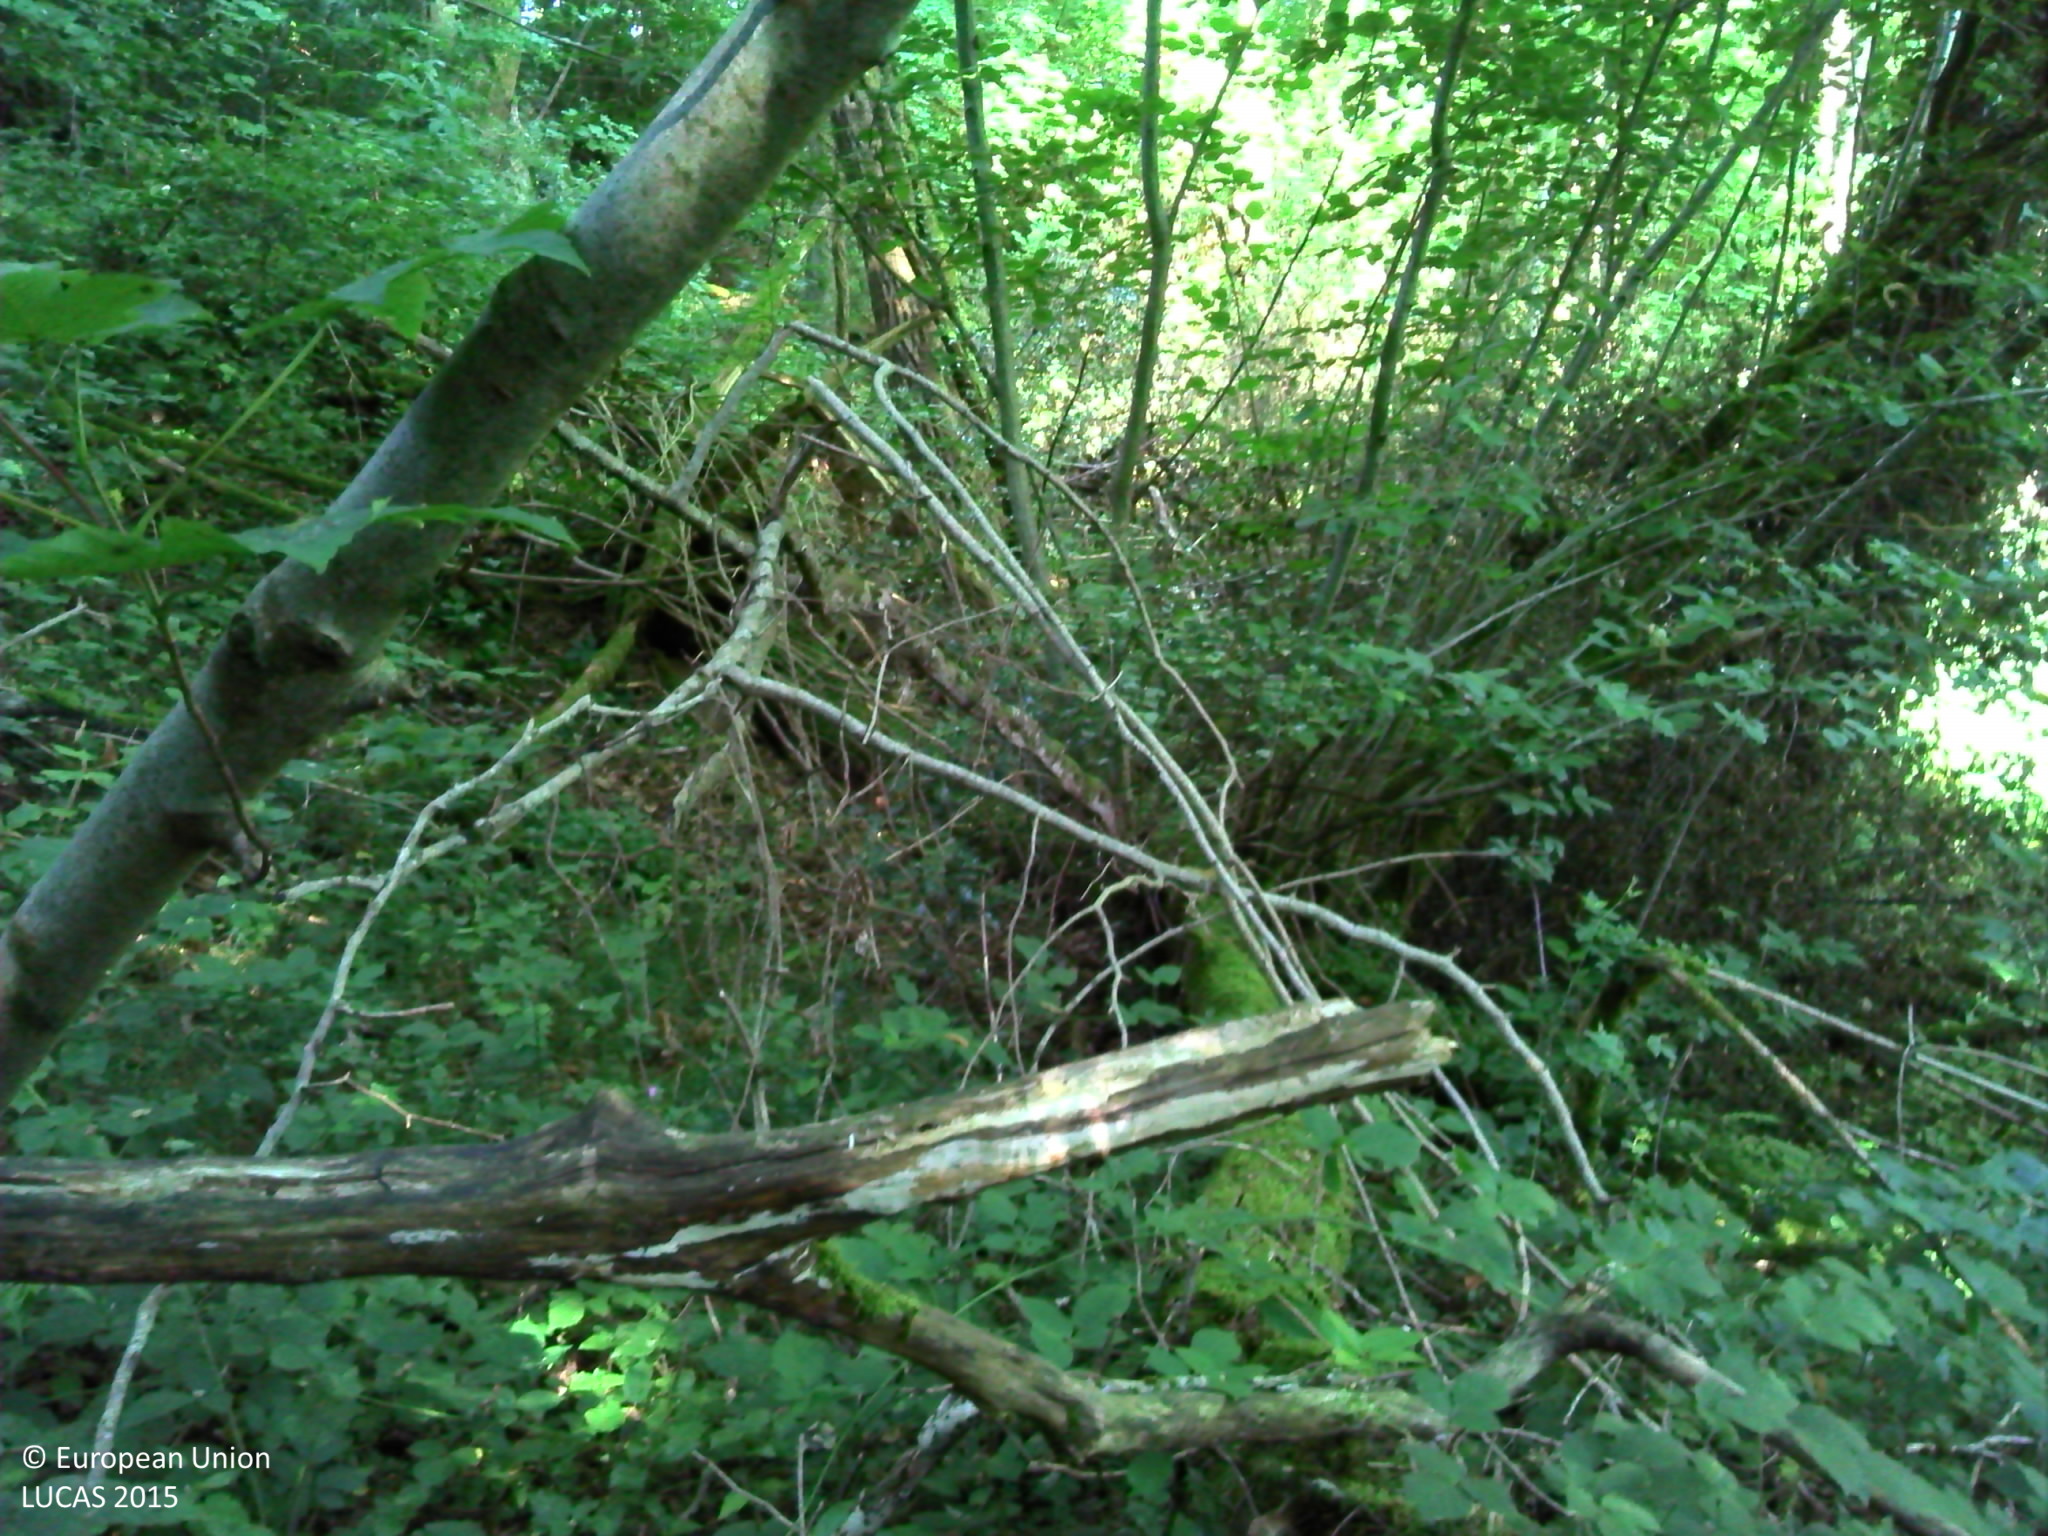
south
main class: Woodland
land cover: Broadleaved woodland
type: acidophilous oak and oak-birch forest
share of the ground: > 75 %
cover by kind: broadleaved forest trees 40 %, herbaceous plants 40 %, lichens and mosses 20 %
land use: Forestry
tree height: > 5 m
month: July
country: FR
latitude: 45.7409
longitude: 1.7297
